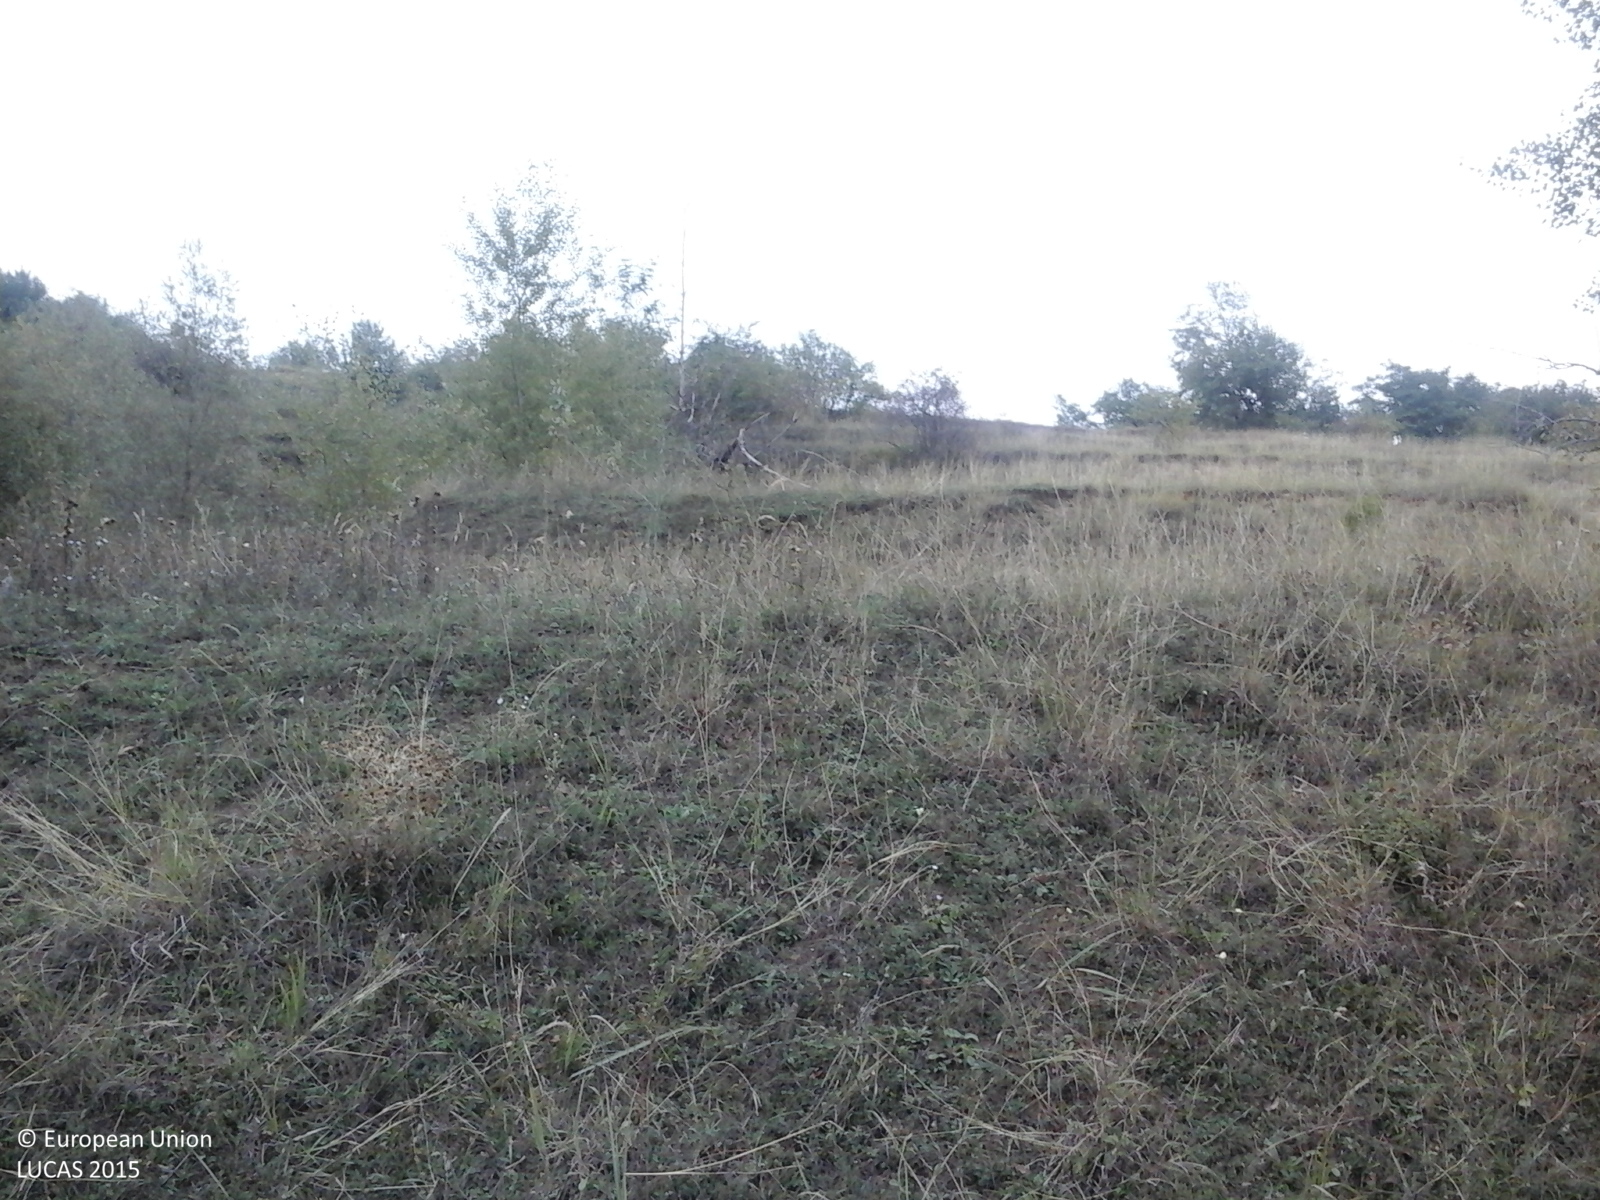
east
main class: Grassland
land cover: Spontaneously vegetated surfaces
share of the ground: > 75 %
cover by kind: herbaceous plants 100 %
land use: Fallow land
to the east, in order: Spontaneously vegetated surfaces; Shrubland without tree cover; Spontaneously vegetated surfaces; Shrubland without tree cover; Grassland with sparse tree/shrub cover
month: September
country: RO
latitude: 45.8466
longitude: 23.2844
